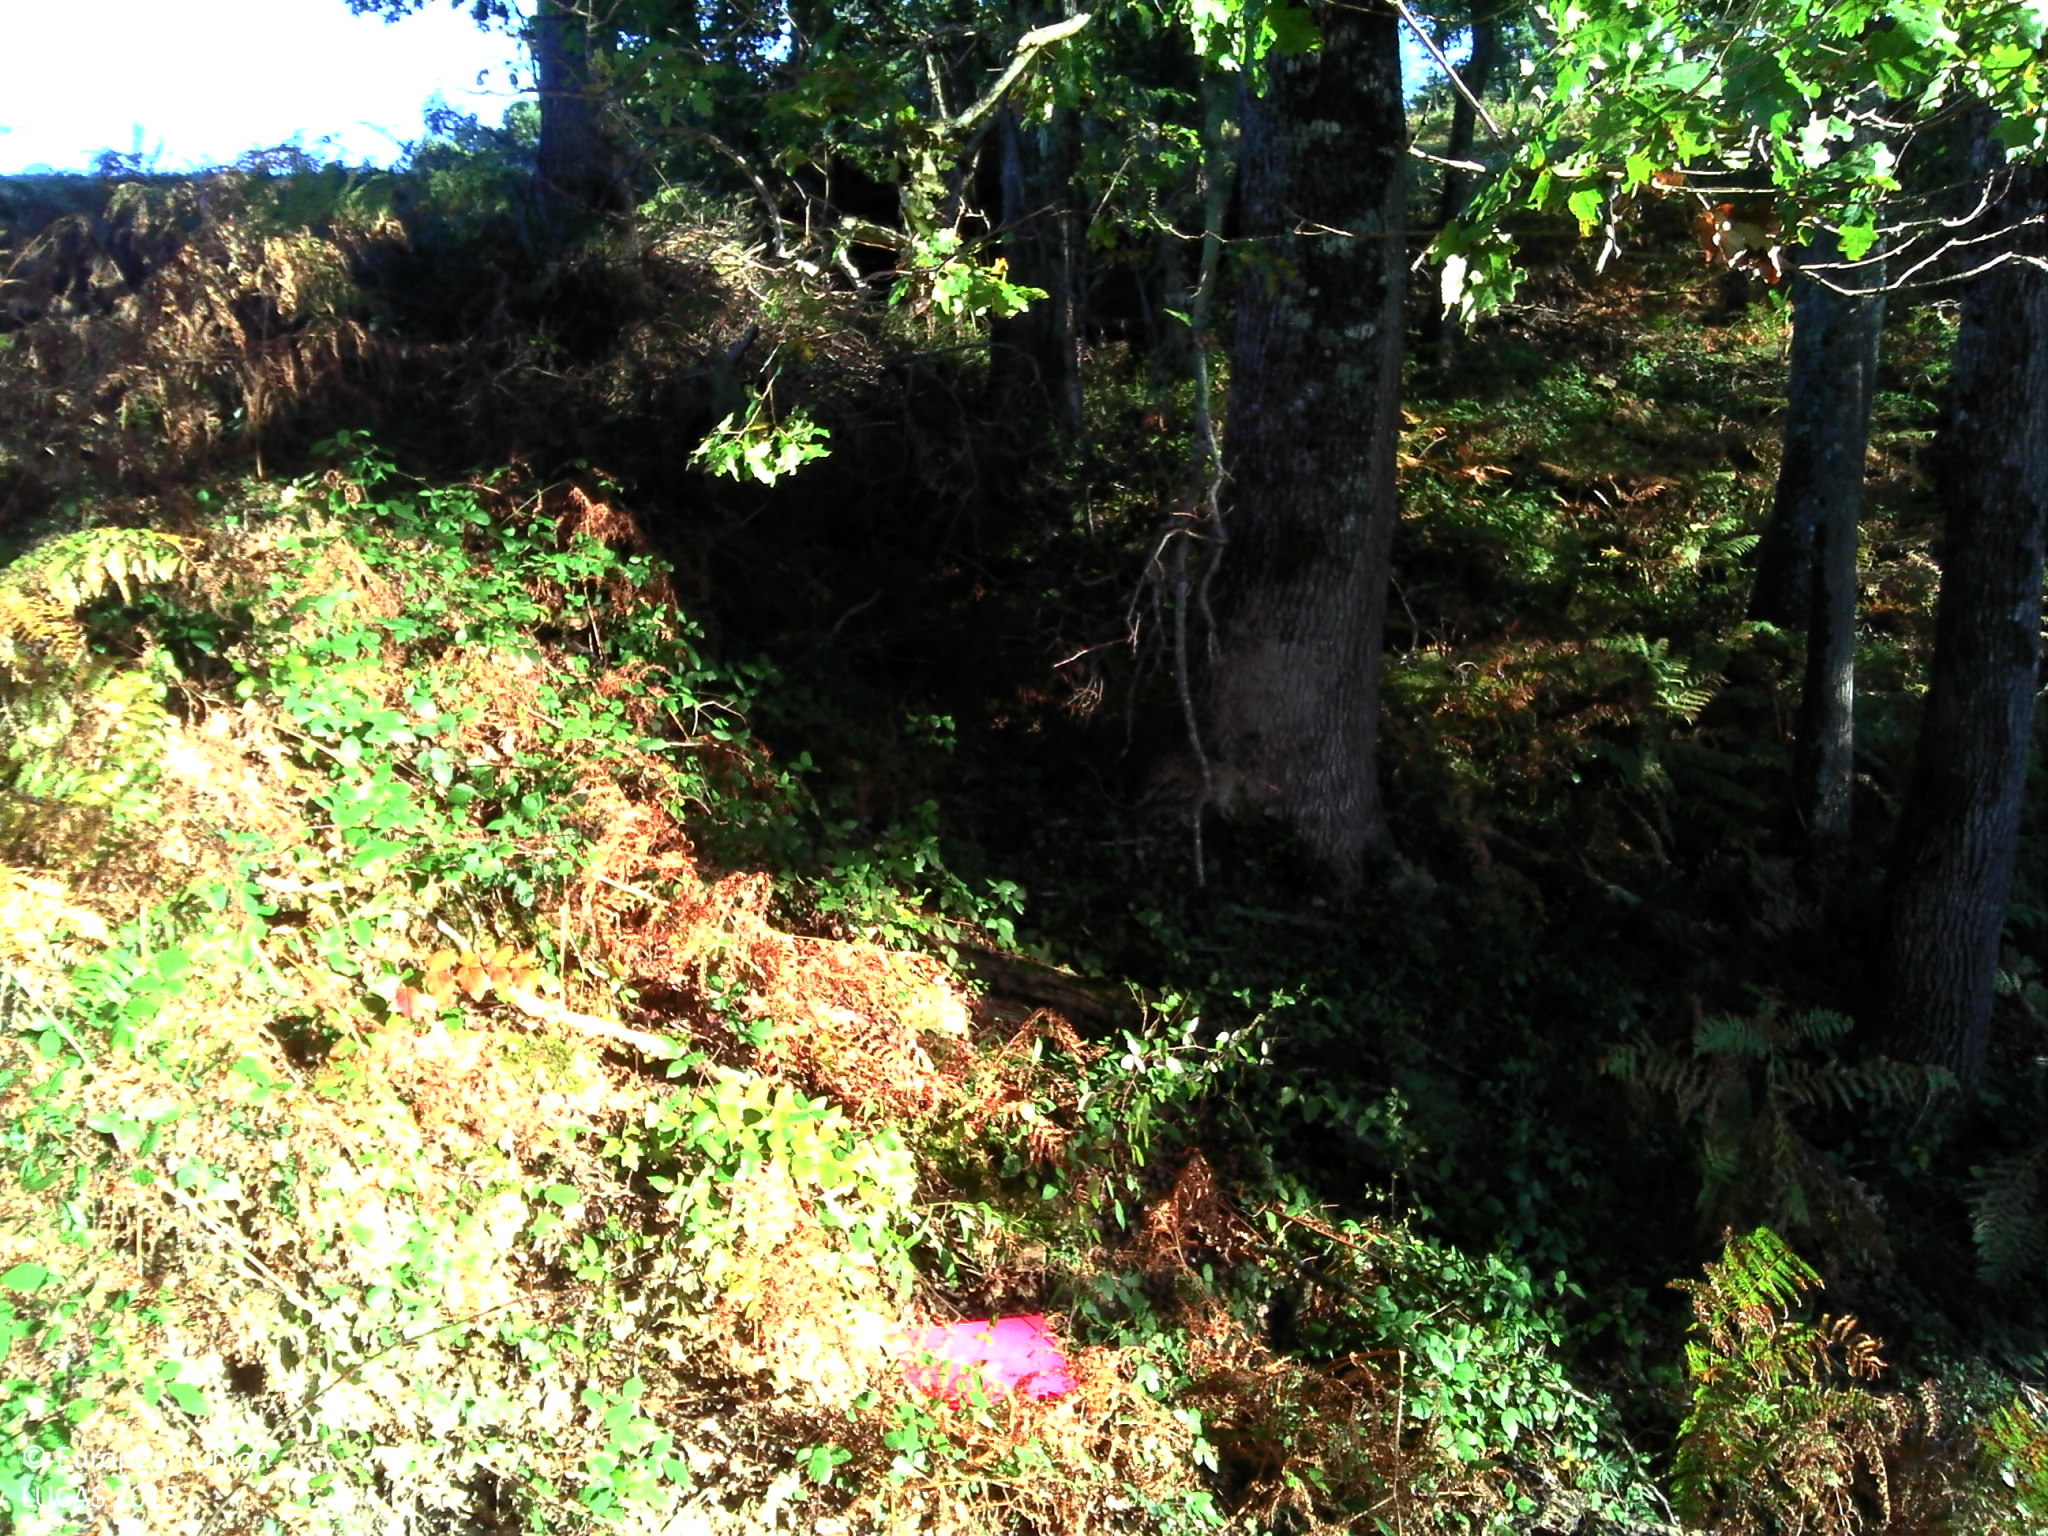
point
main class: Woodland
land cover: Broadleaved woodland
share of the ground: 50 - 75 %
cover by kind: broadleaved forest trees 65 %, herbaceous plants 20 %, shrubs 10 %, lichens and mosses 5 %
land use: Forestry
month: September
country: FR
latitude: 43.1979
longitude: -0.6781
